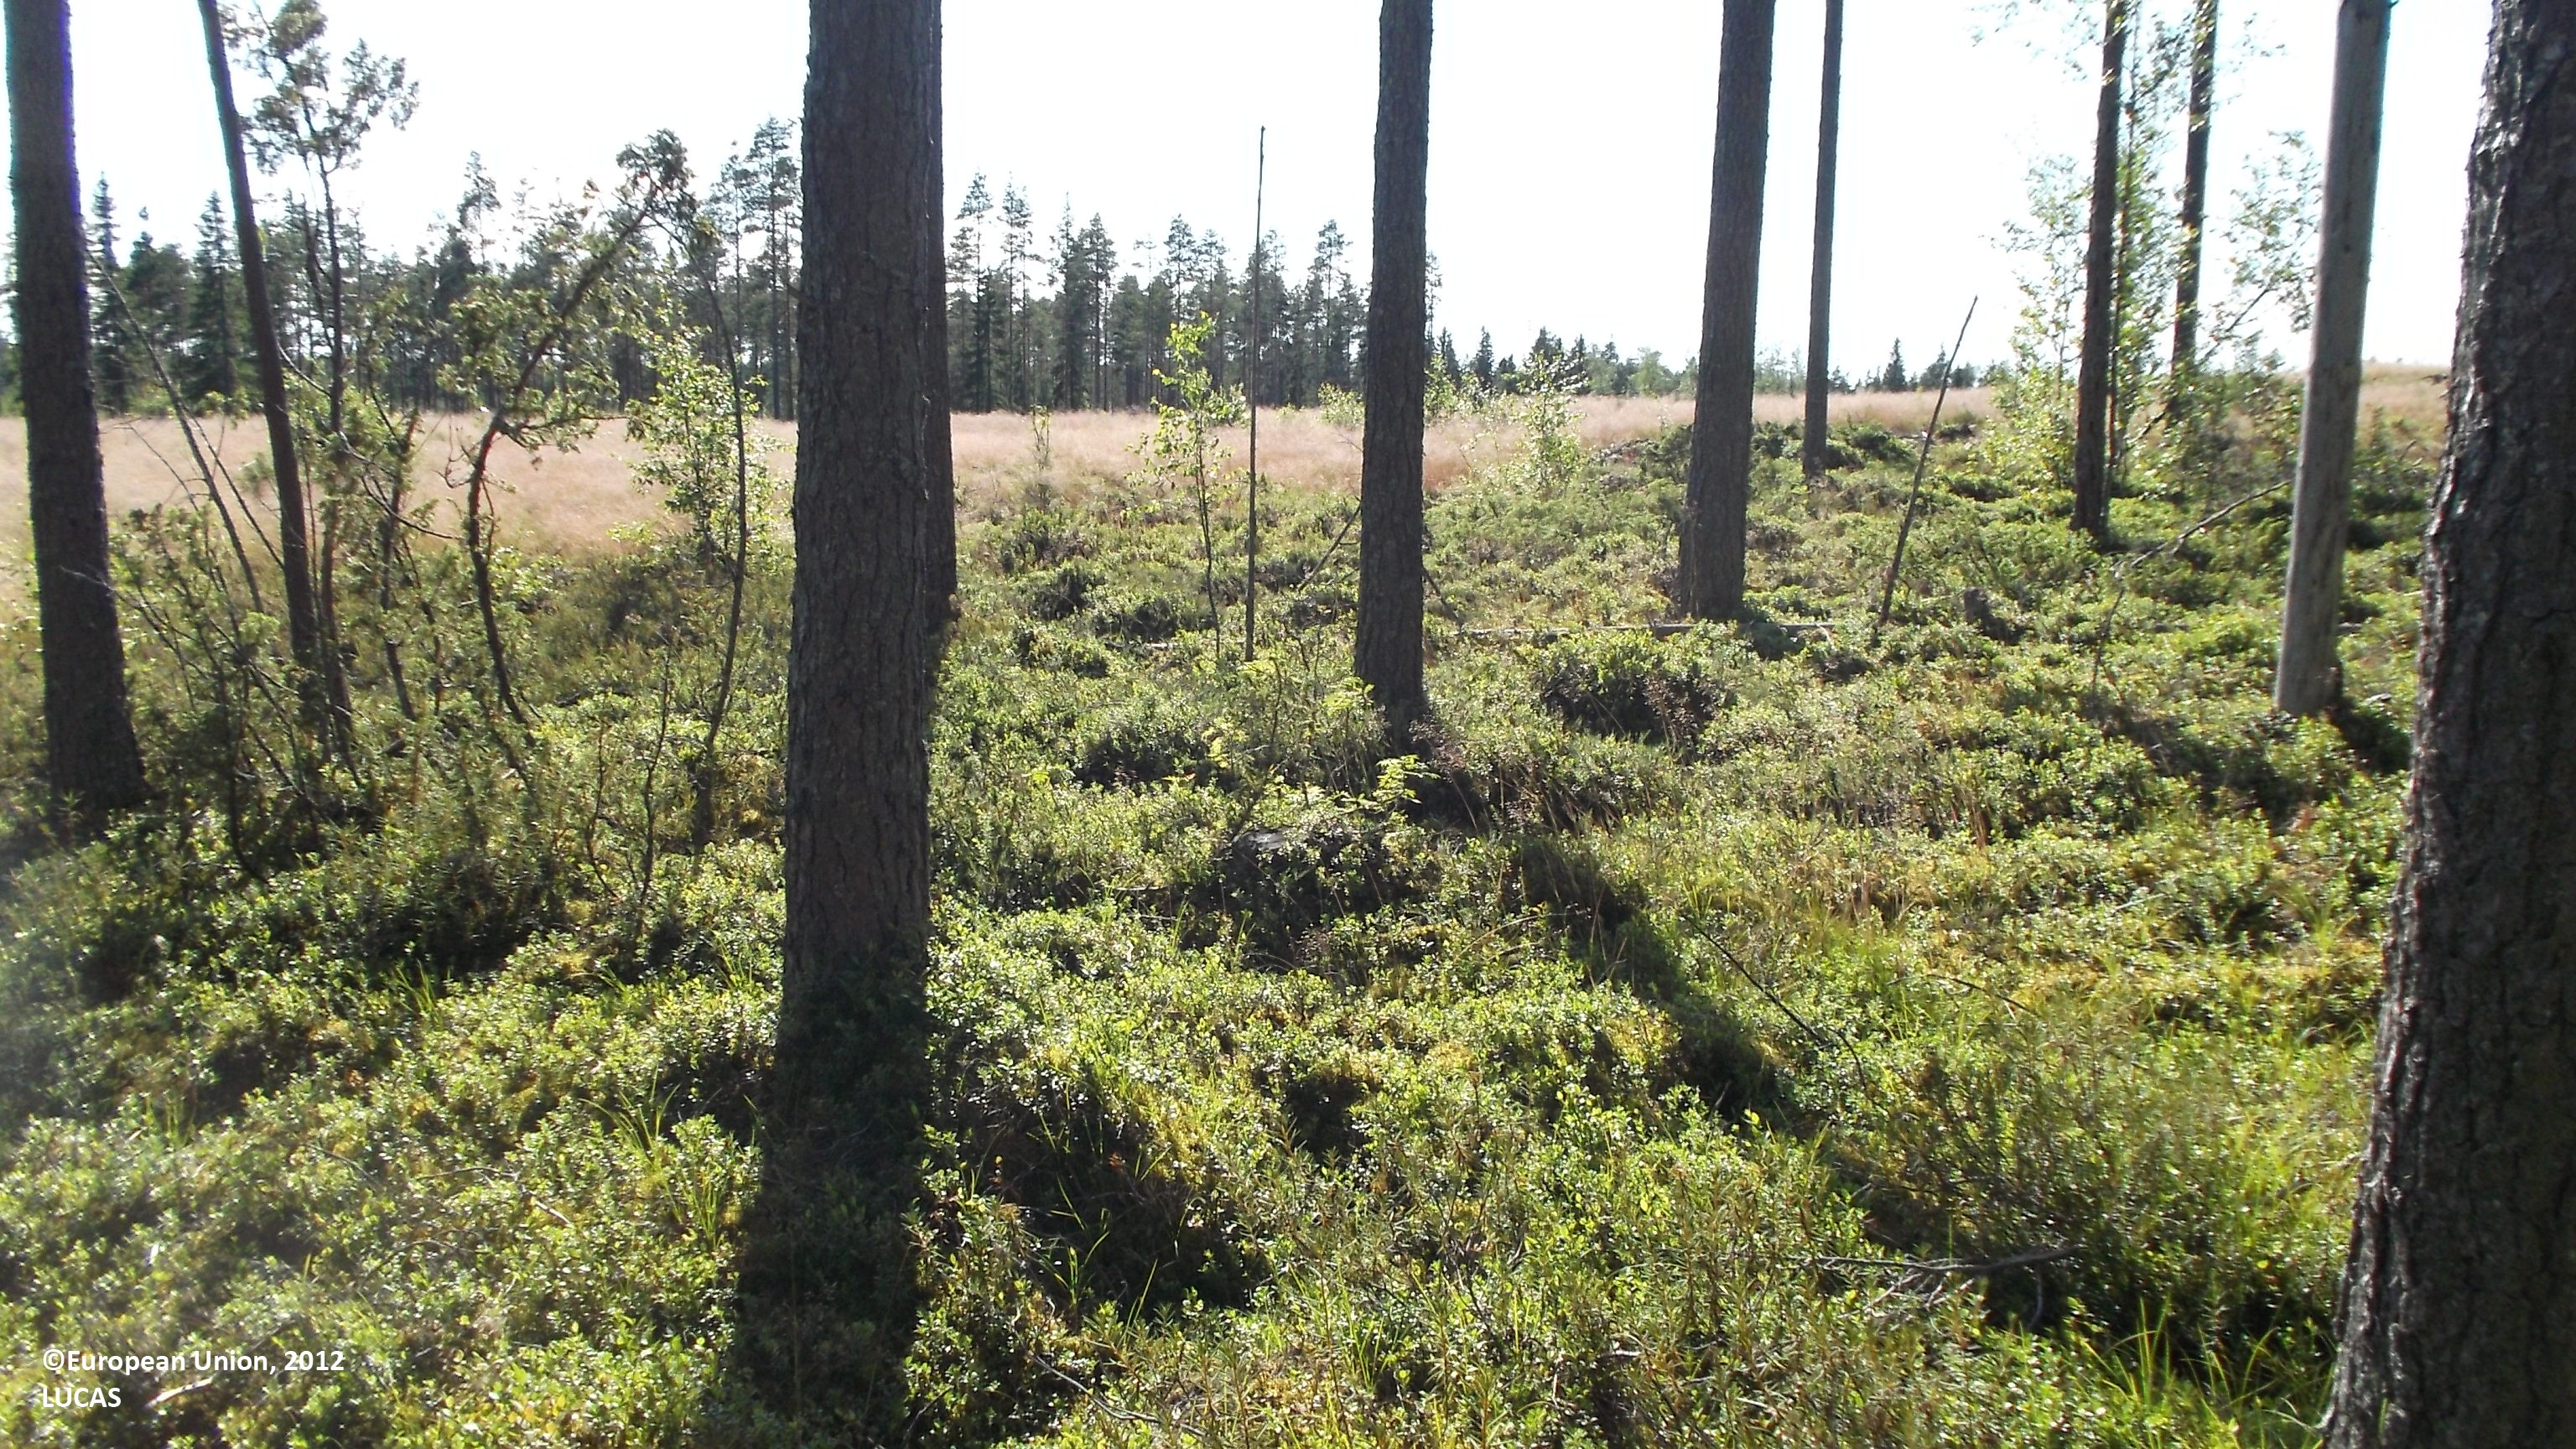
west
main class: Woodland
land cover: Pine dominated coniferous woodland
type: boreal forest
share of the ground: 25 - 50 %
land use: Forestry
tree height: > 5 m
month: July
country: FI
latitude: 63.7172
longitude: 23.8090
